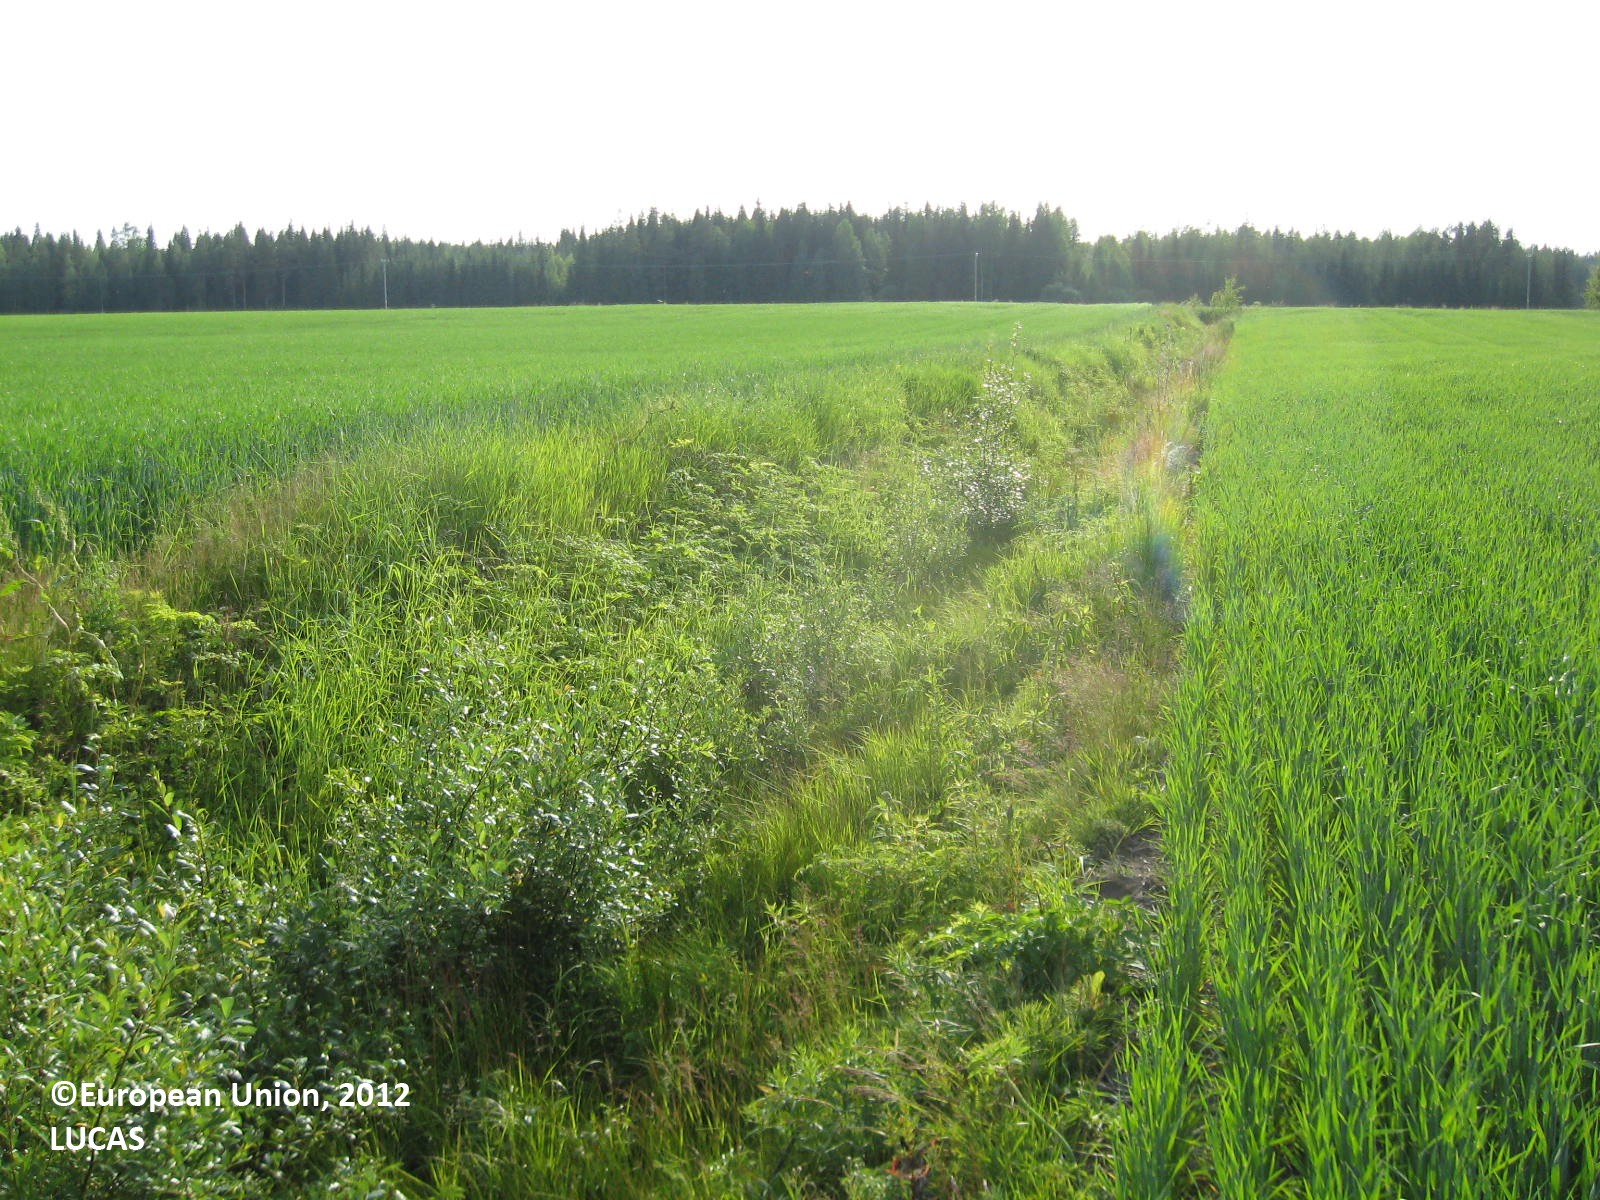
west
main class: Cropland
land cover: Barley
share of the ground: > 75 %
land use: Agriculture (excluding fallow land and kitchen gardens)
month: July
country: FI
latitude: 62.5183
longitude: 21.7198
